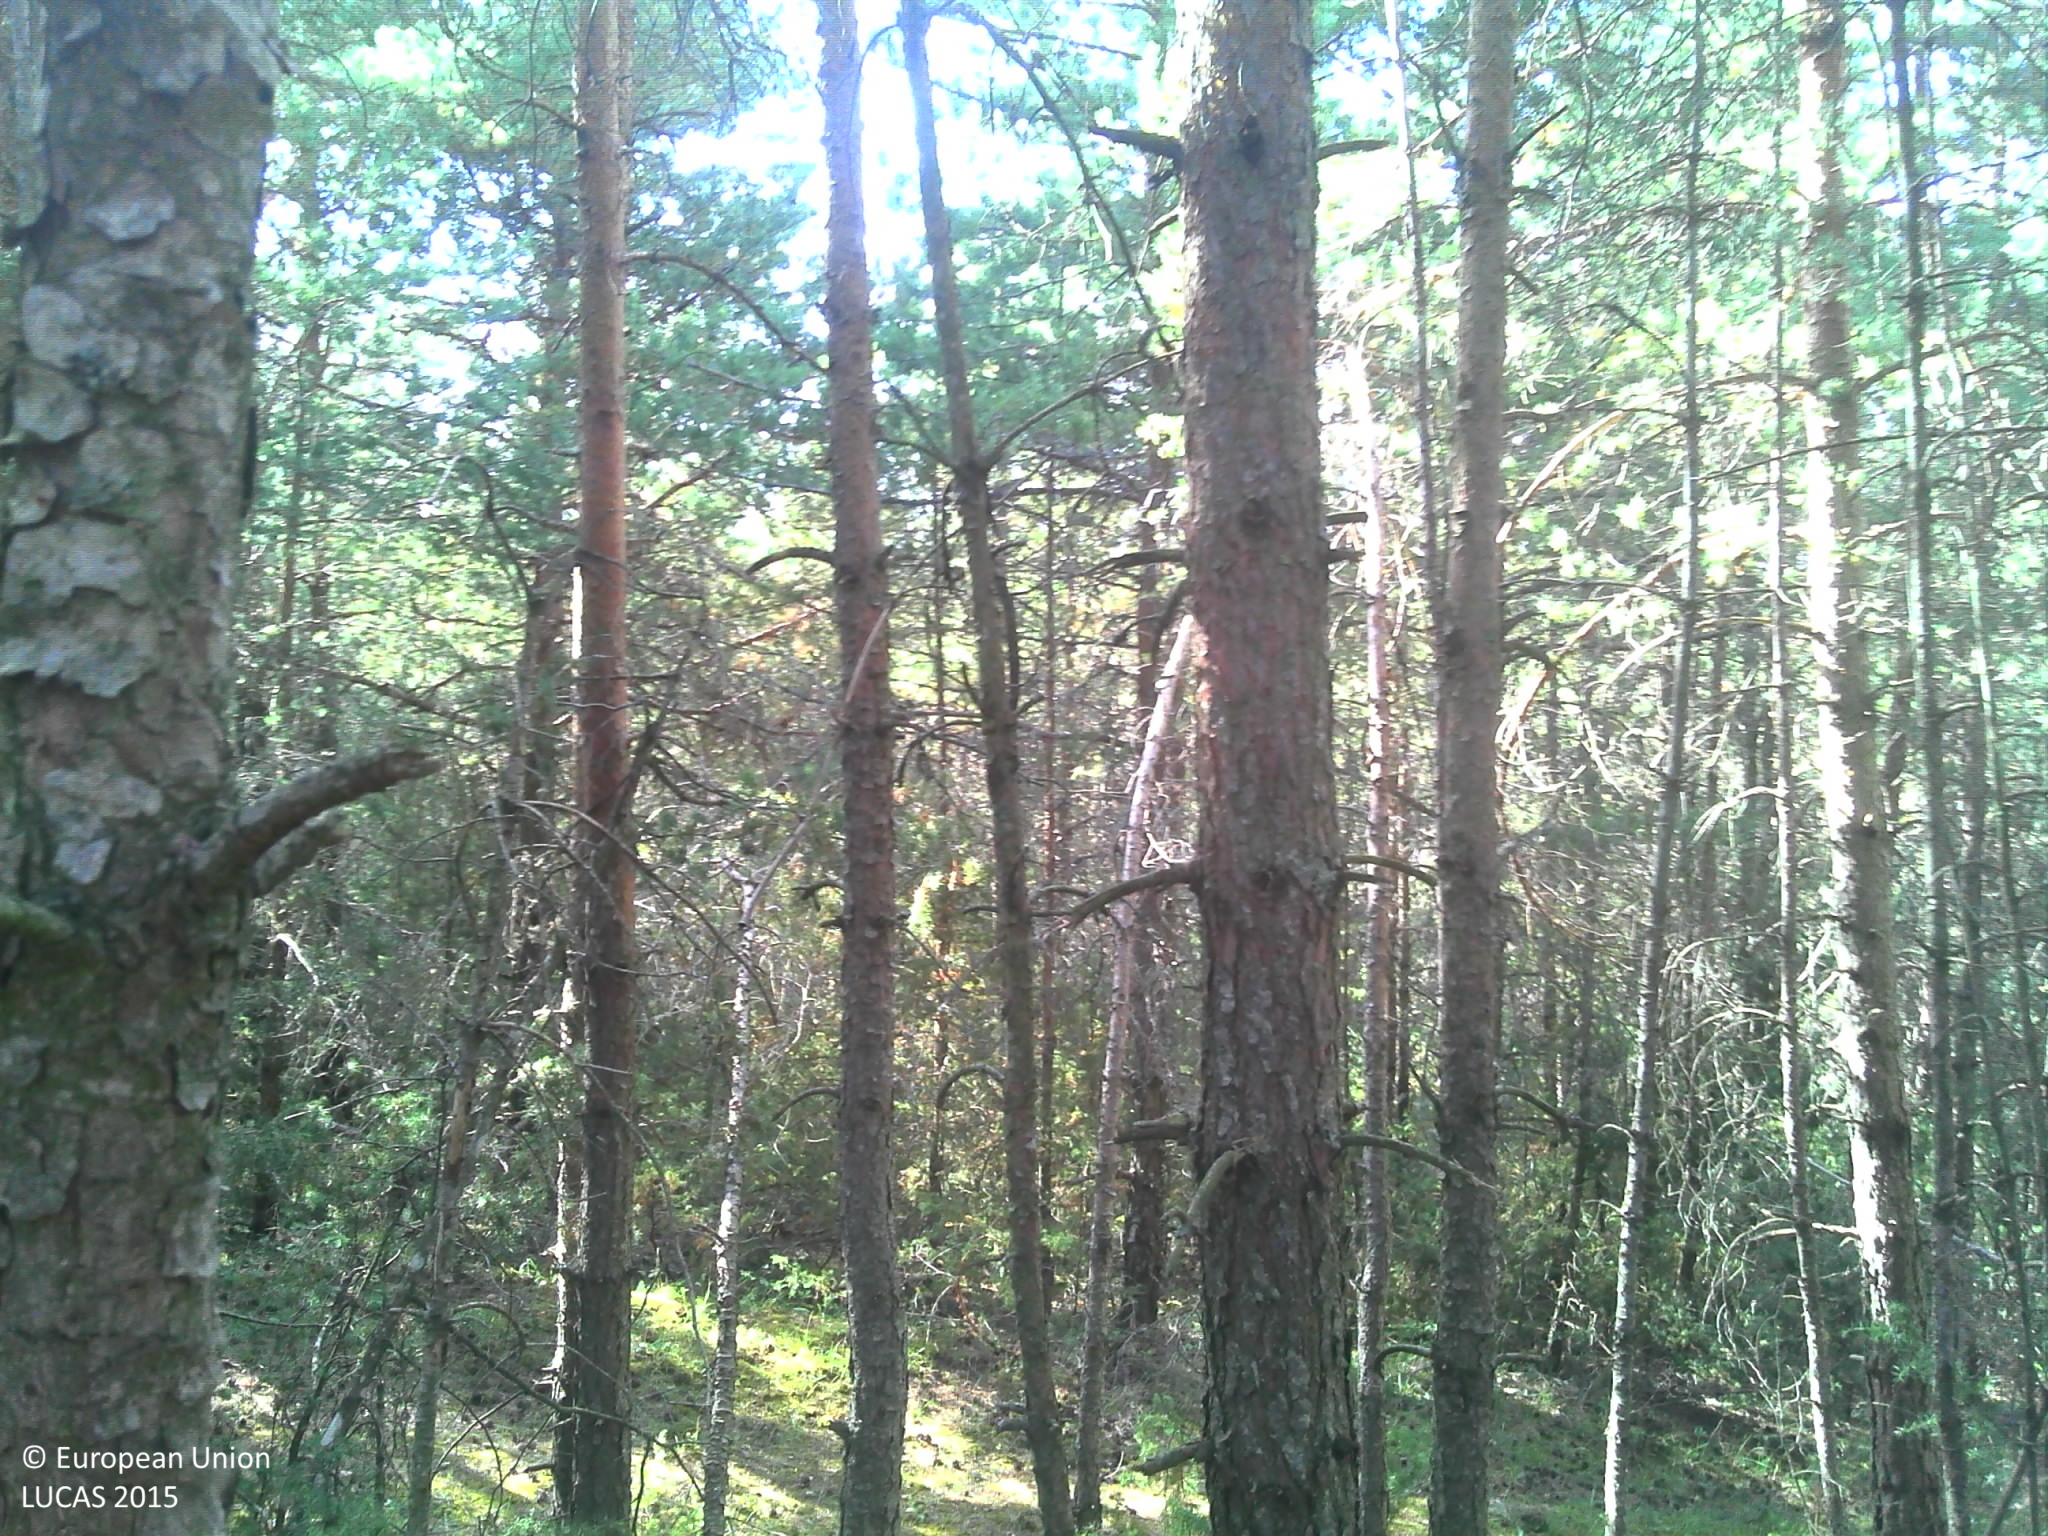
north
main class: Woodland
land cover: Pine dominated coniferous woodland
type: hemiboreal forest and nemoral coniferous forest and mixed broadleaved-coniferous forest
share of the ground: > 75 %
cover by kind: coniferous forest trees 95 %, broadleaved forest trees 5 %
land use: Forestry
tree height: > 5 m
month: July
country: FR
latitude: 44.5253
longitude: 3.1974
